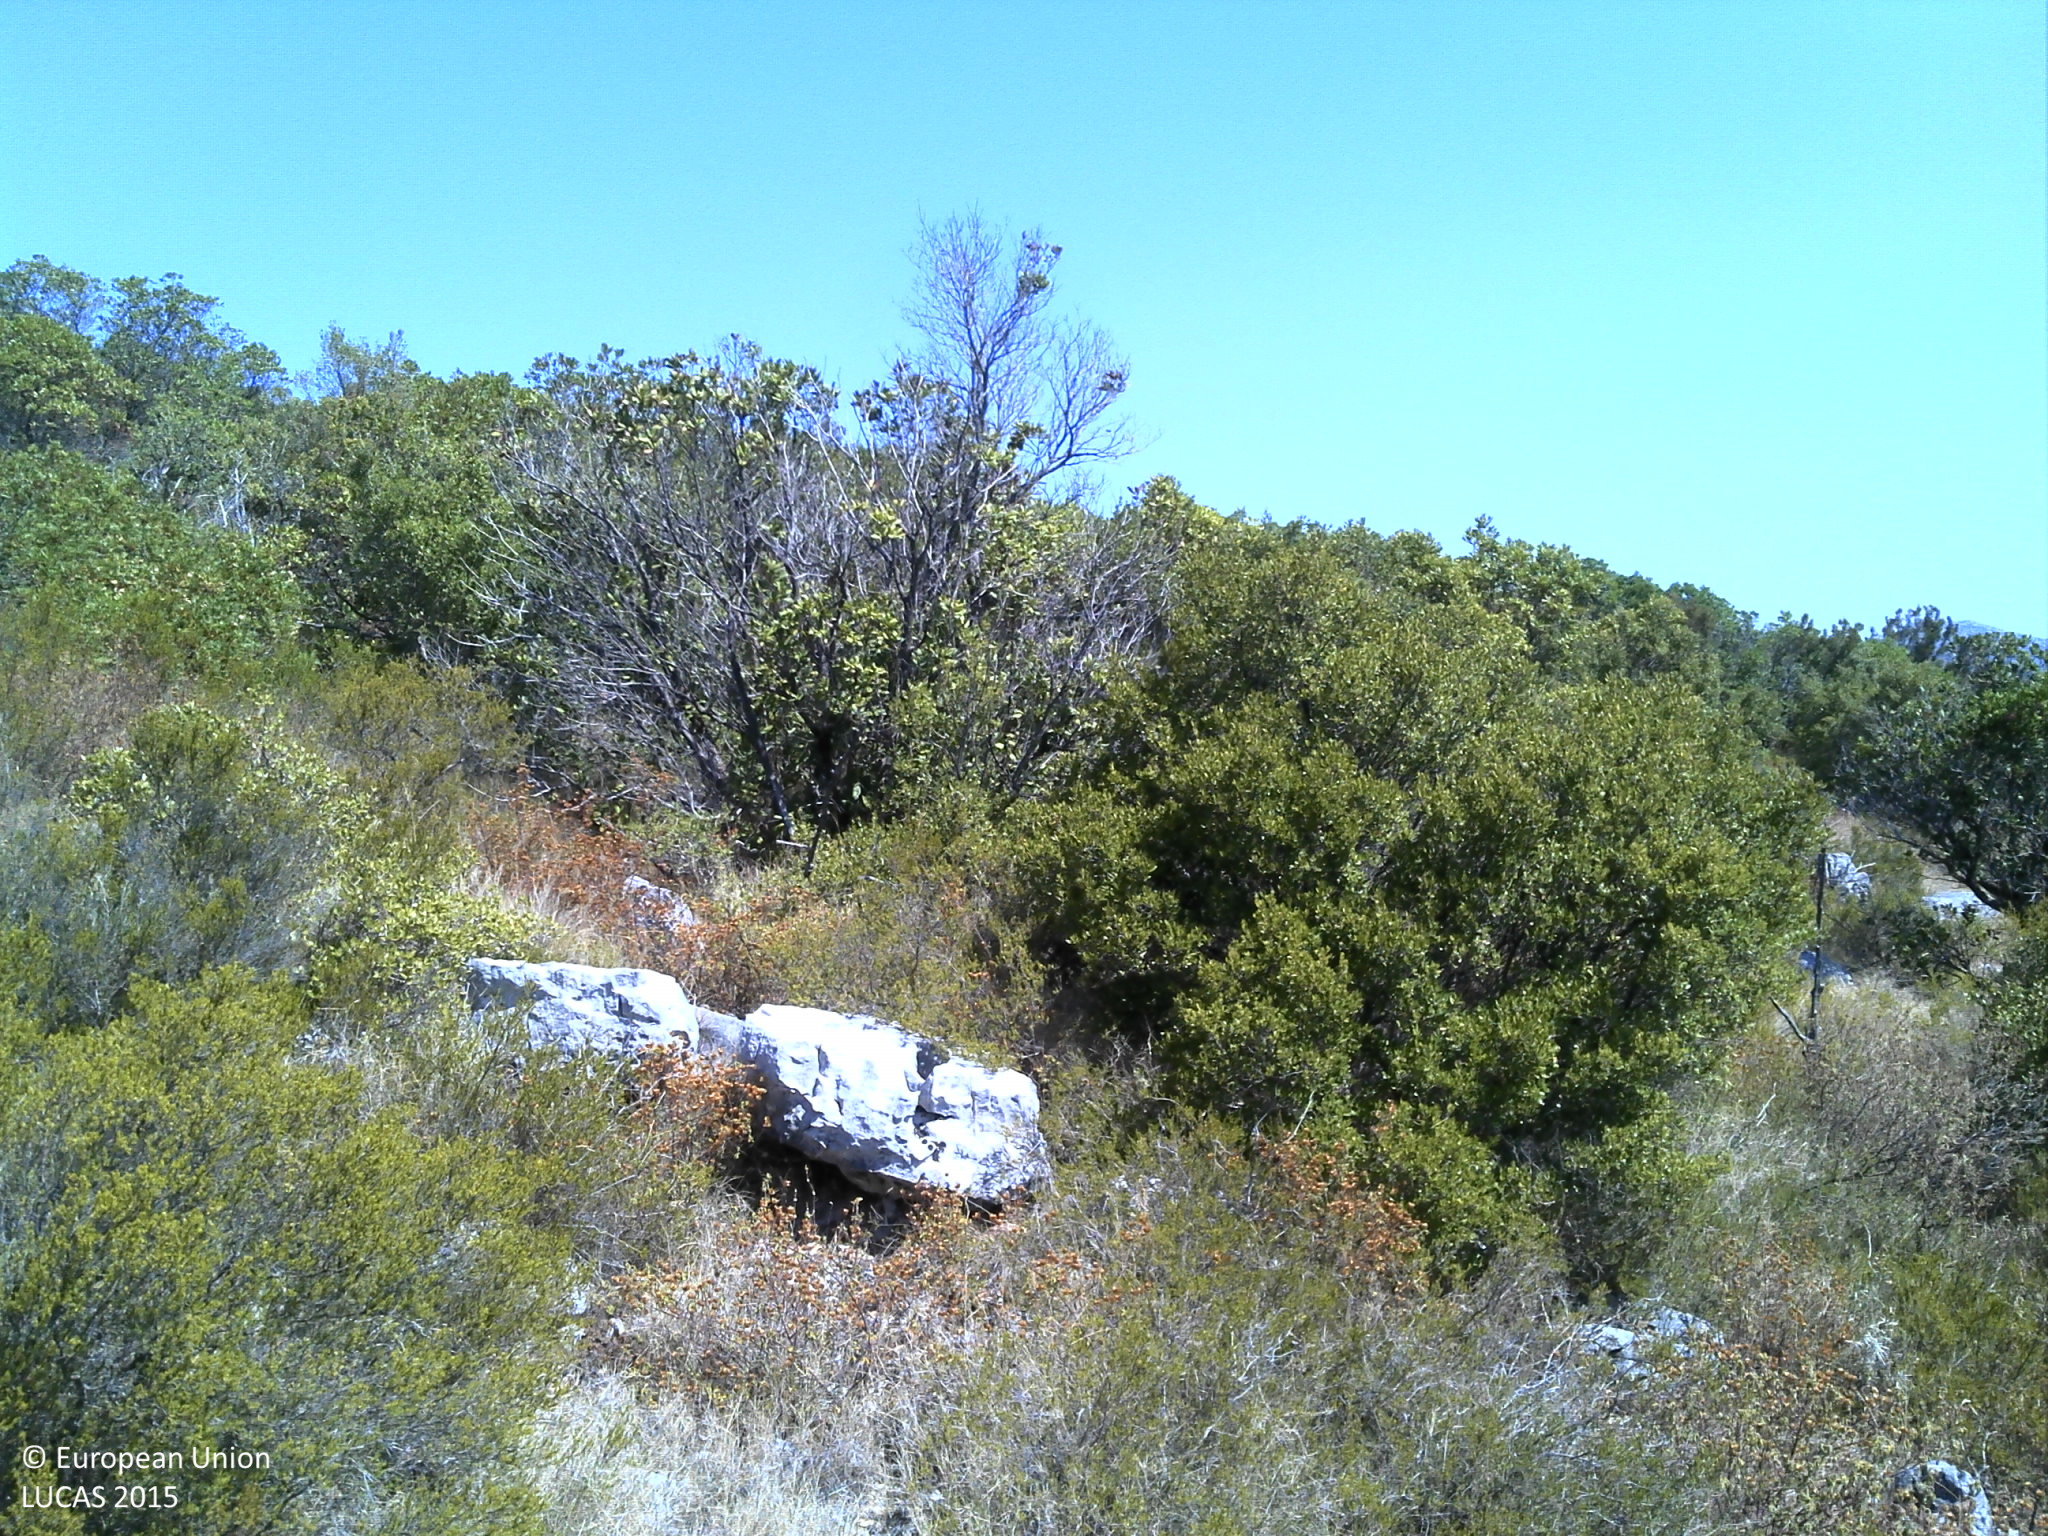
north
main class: Shrubland
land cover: Shrubland without tree cover
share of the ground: 50 - 75 %
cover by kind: shrubs 60 %, consolidated bare surface 15 %, unconsolidated bare surface 15 %, herbaceous plants 10 %
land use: Semi-natural and natural areas not in use
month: August
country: HR
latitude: 42.9510
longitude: 17.0615
